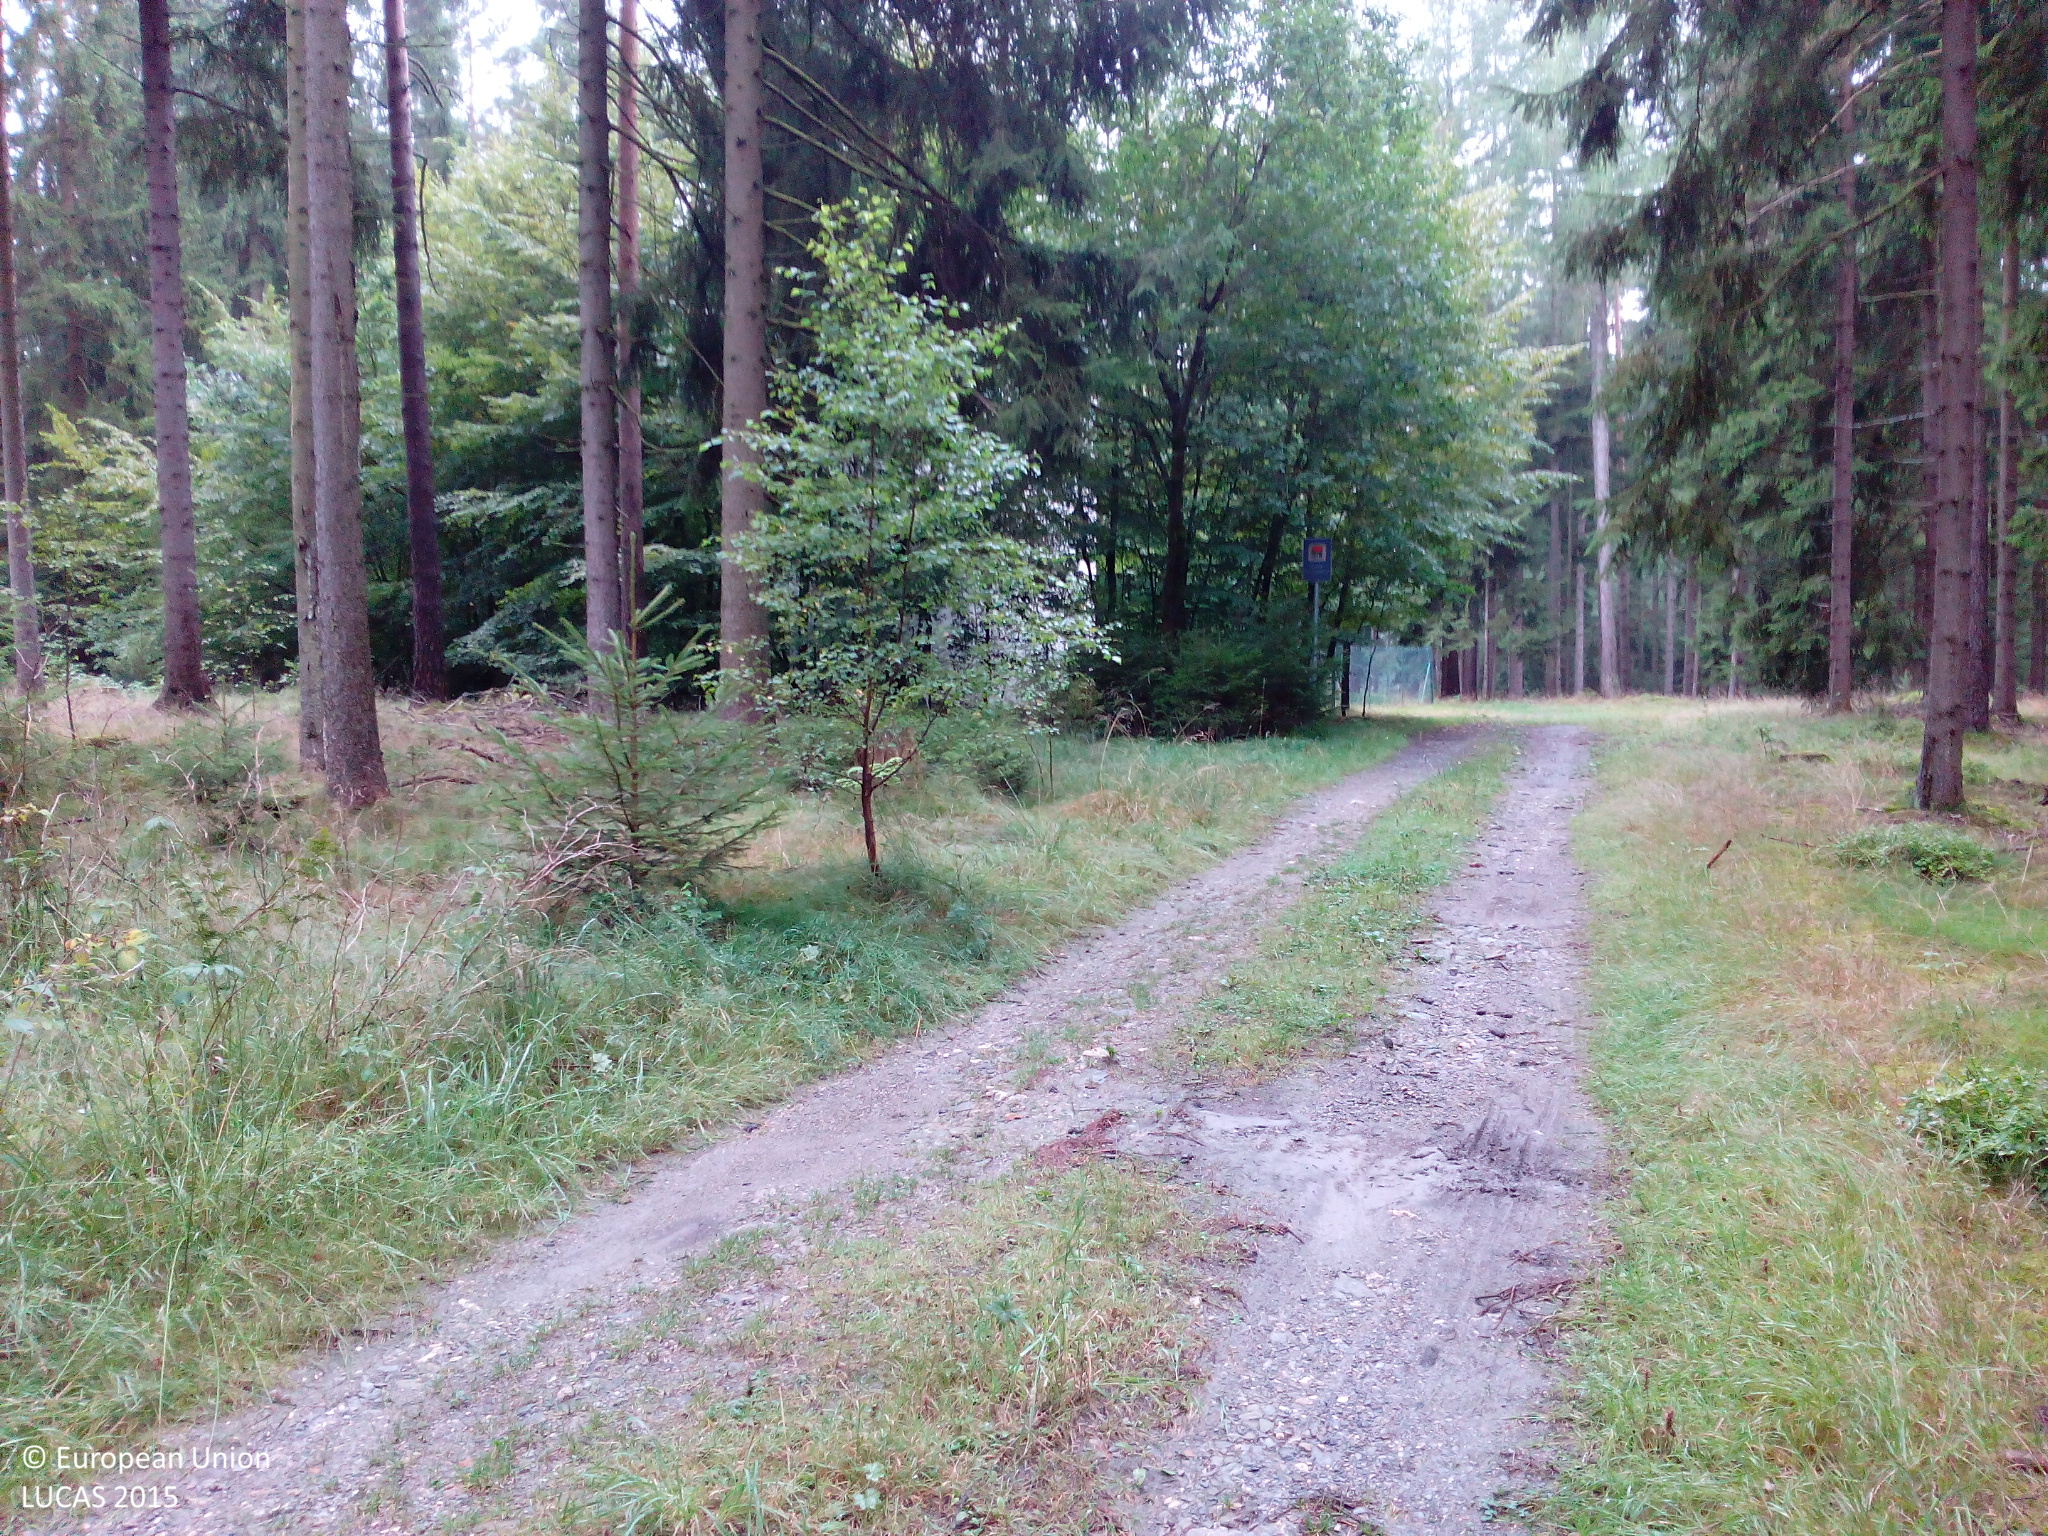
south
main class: Woodland
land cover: Spruce dominated coniferous woodland
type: hemiboreal forest and nemoral coniferous forest and mixed broadleaved-coniferous forest
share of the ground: > 75 %
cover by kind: coniferous forest trees 75 %, lichens and mosses 20 %, shrubs 5 %
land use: Forestry
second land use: Amenities, museums, leisure
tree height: > 5 m
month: August
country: DE
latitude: 50.2910
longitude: 12.0910
